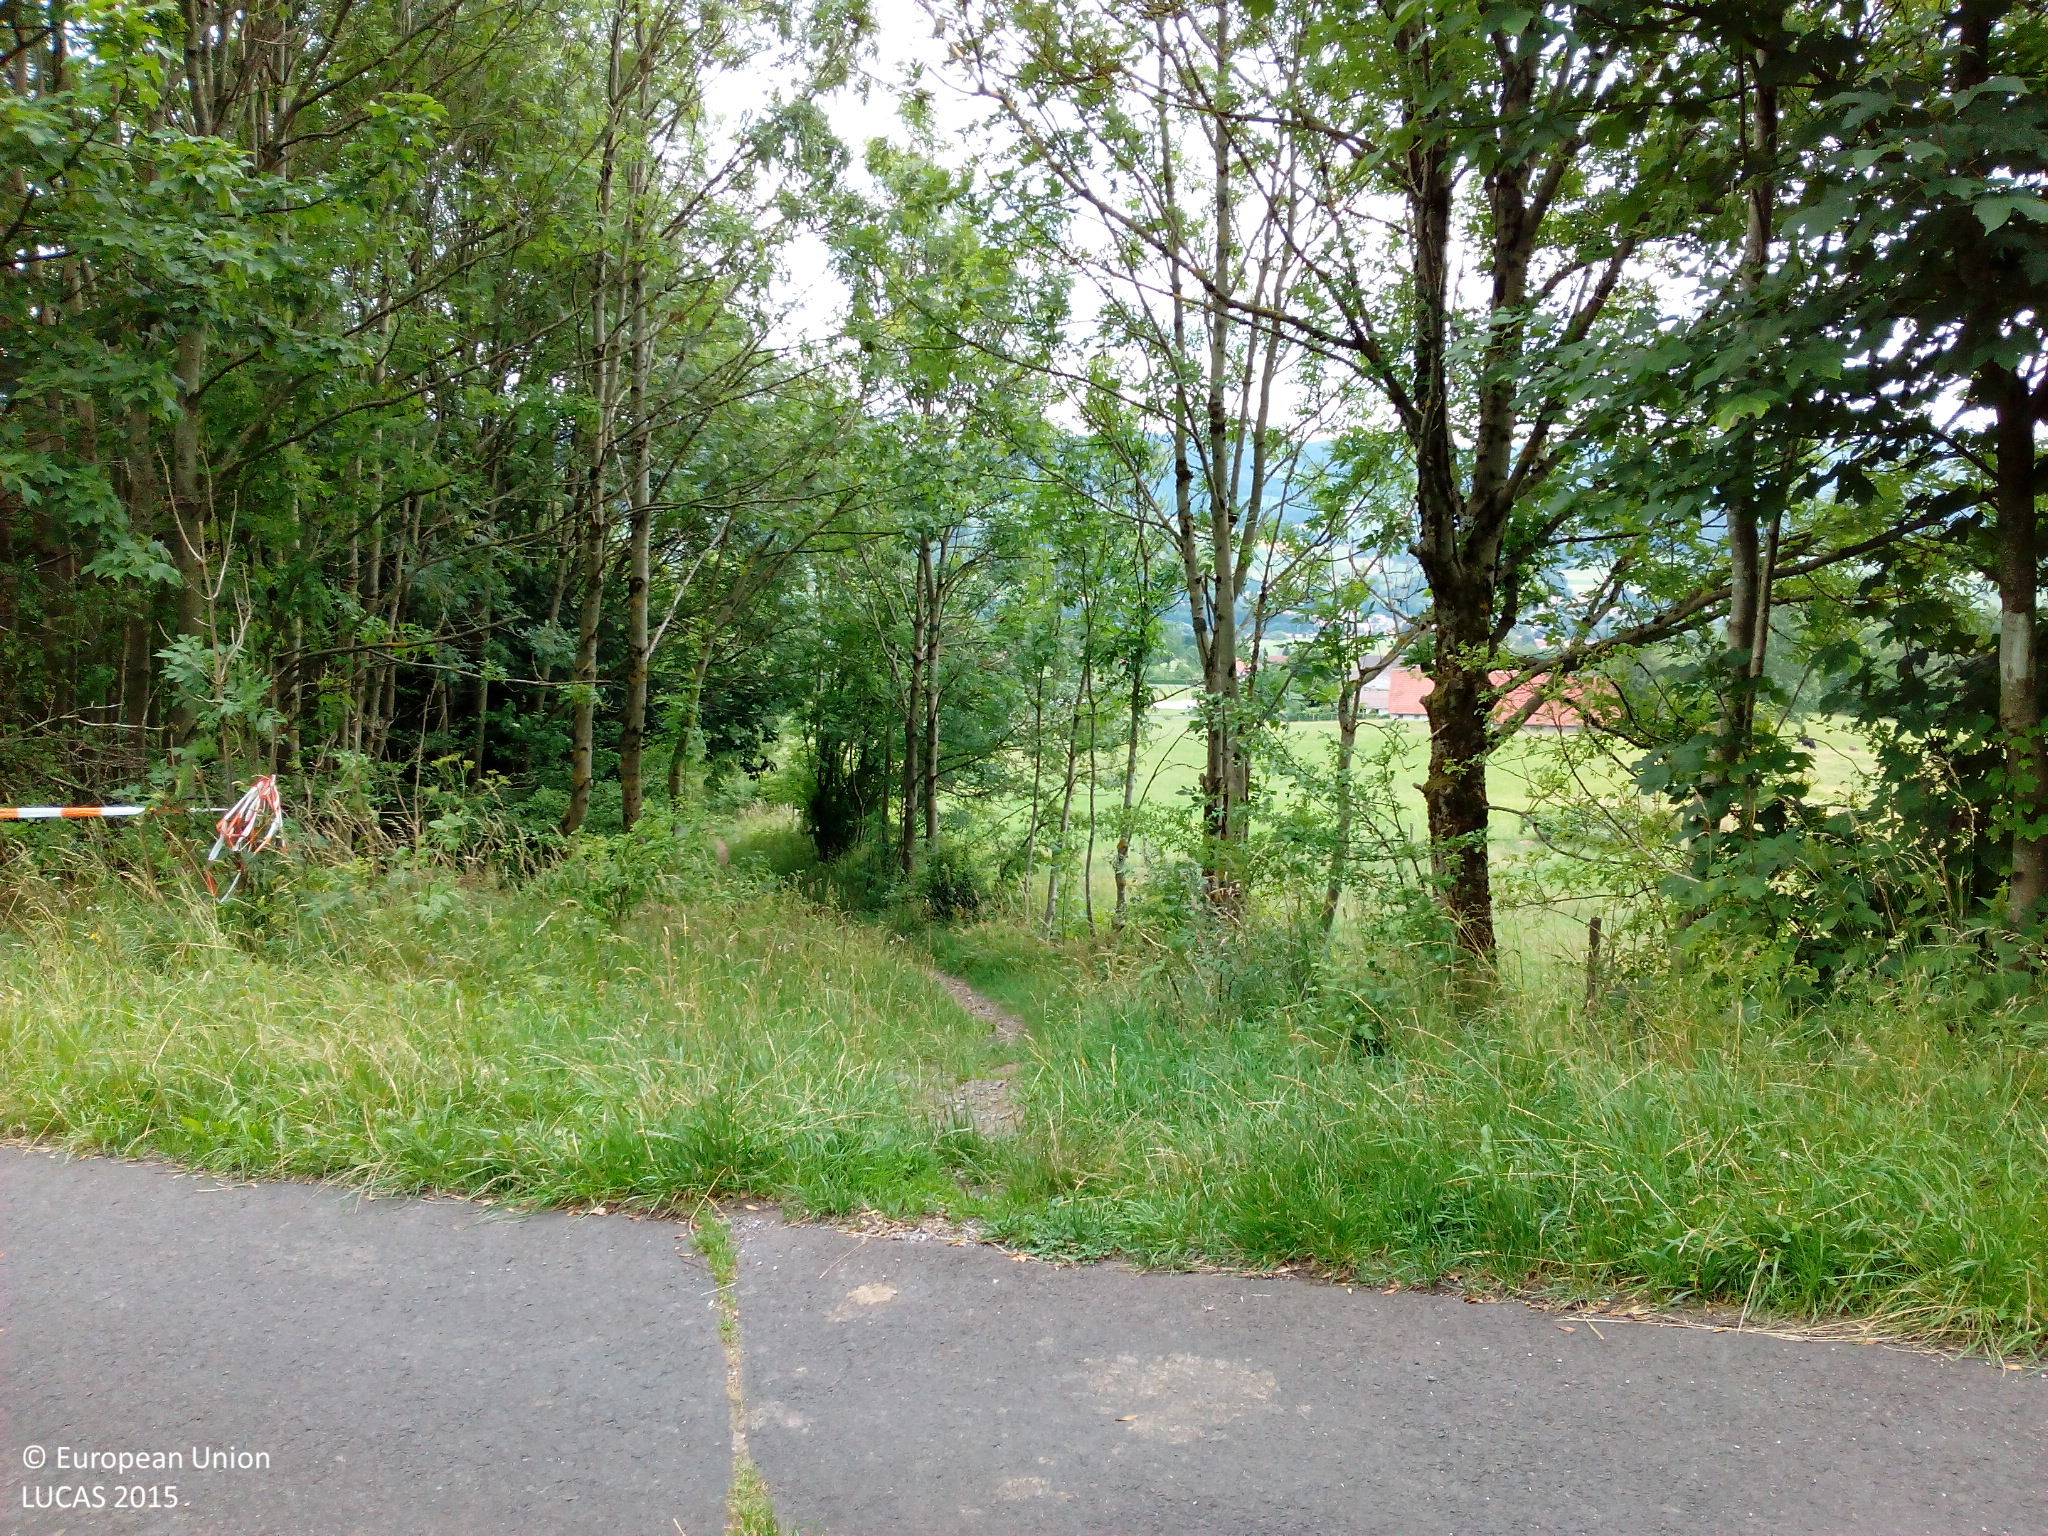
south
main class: Woodland
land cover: Broadleaved woodland
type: thermophilous deciduous forest
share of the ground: > 75 %
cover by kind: broadleaved forest trees 75 %, herbaceous plants 15 %, shrubs 10 %
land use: Agriculture (excluding fallow land and kitchen gardens)
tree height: > 5 m
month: July
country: DE
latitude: 50.4719
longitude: 9.9296
